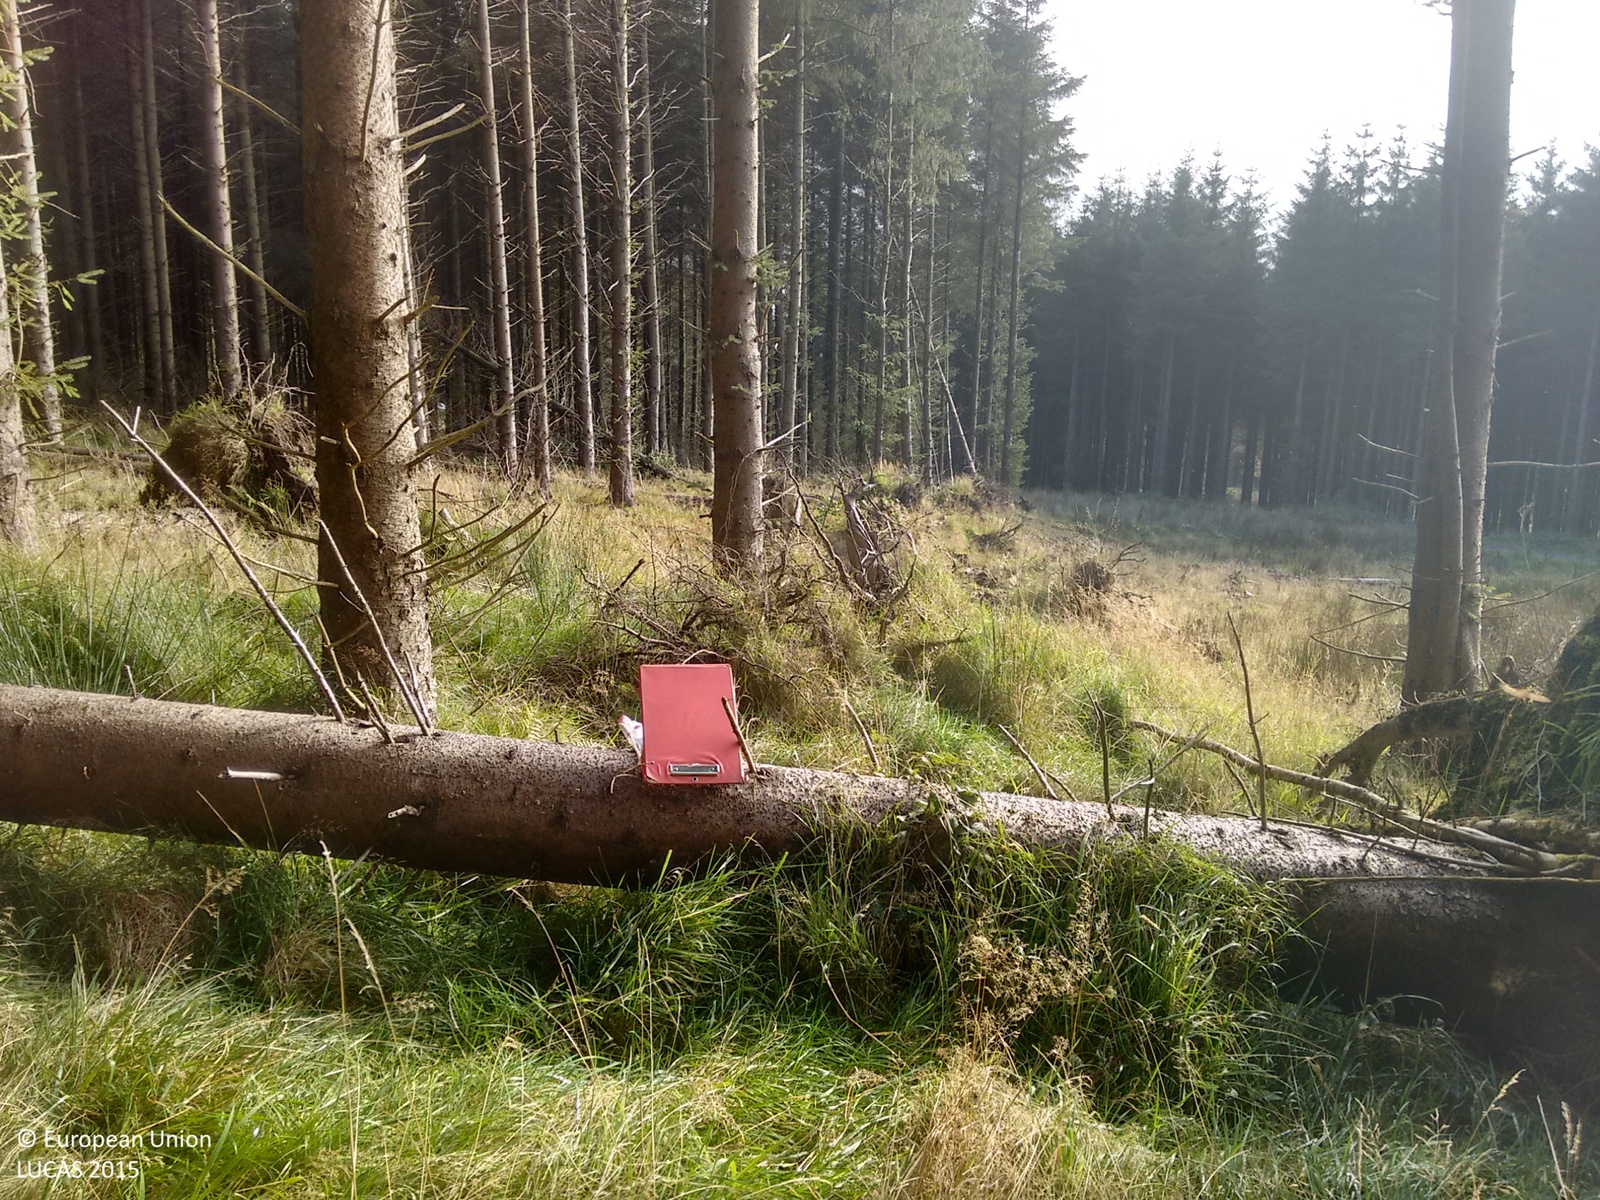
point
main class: Woodland
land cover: Spruce dominated coniferous woodland
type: exotic forest
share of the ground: > 75 %
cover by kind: coniferous forest trees 65 %, herbaceous plants 35 %
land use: Forestry
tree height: > 5 m
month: October
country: IE
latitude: 52.9905
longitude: -7.6686
